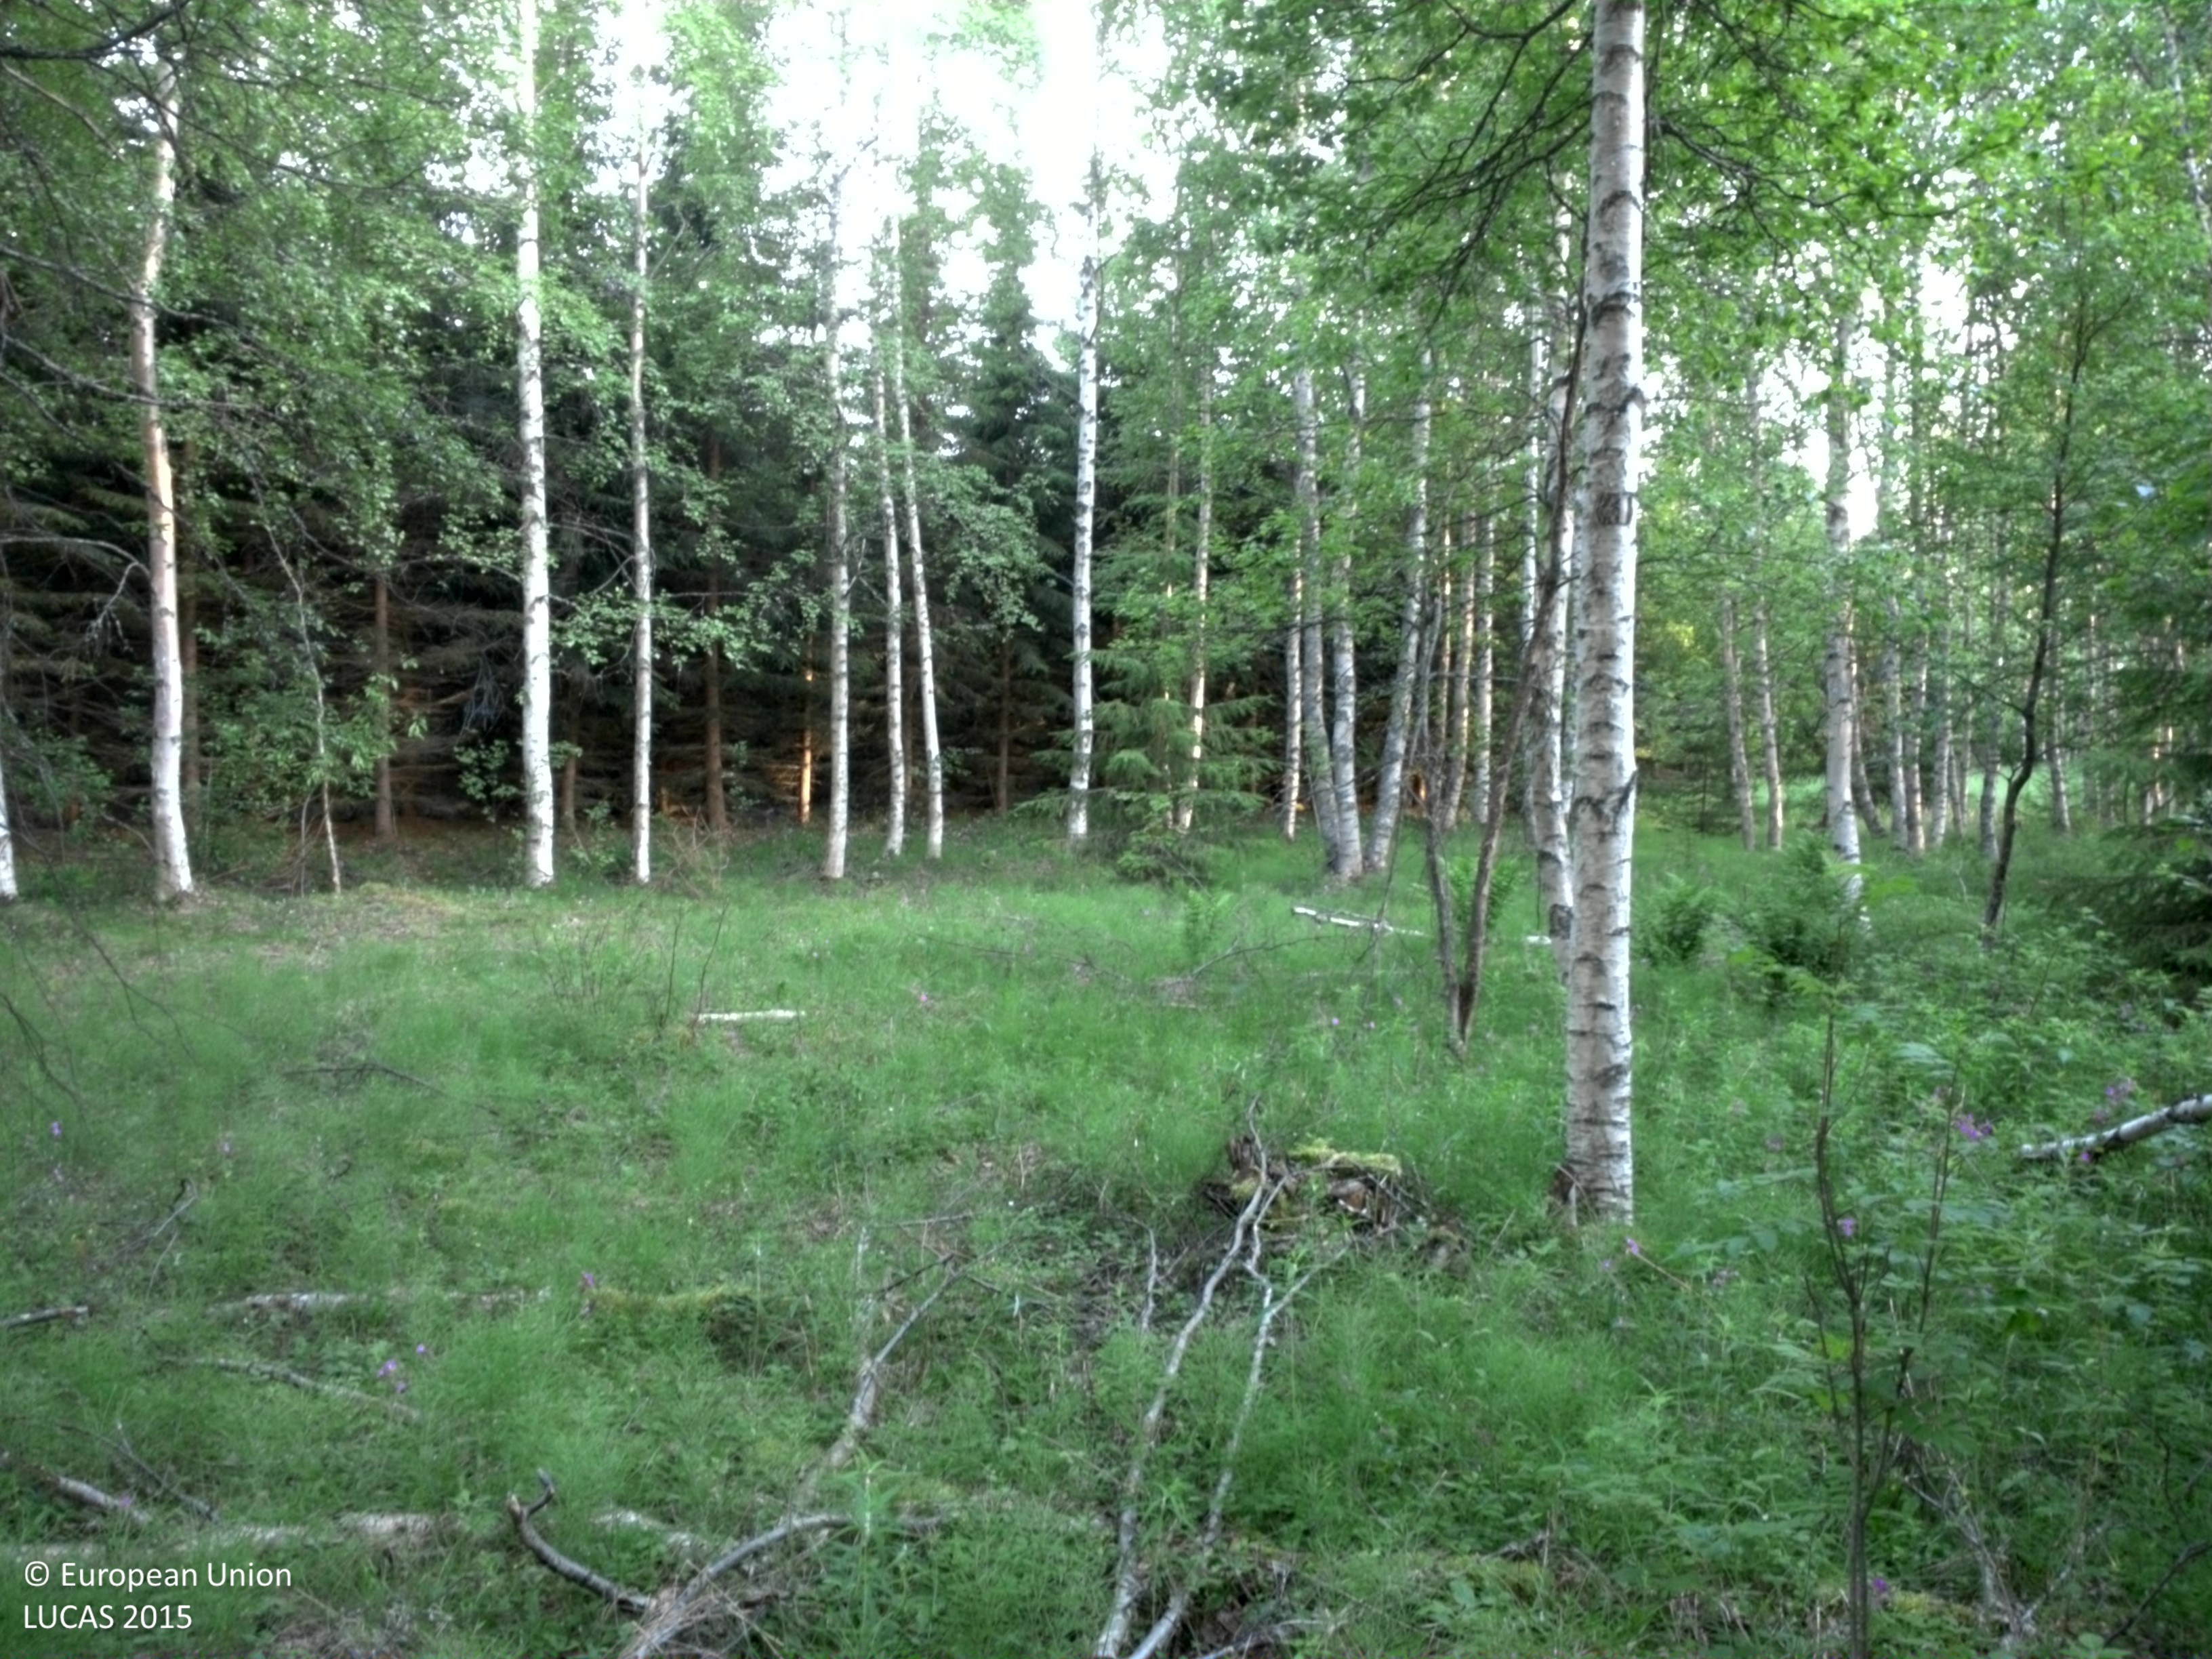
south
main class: Woodland
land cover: Spruce dominated mixed woodland
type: boreal forest
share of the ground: > 75 %
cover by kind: coniferous forest trees 50 %, broadleaved forest trees 30 %, shrubs 10 %, herbaceous plants 10 %
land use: Forestry
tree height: > 5 m
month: July
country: SE
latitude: 64.4868
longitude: 20.7789
